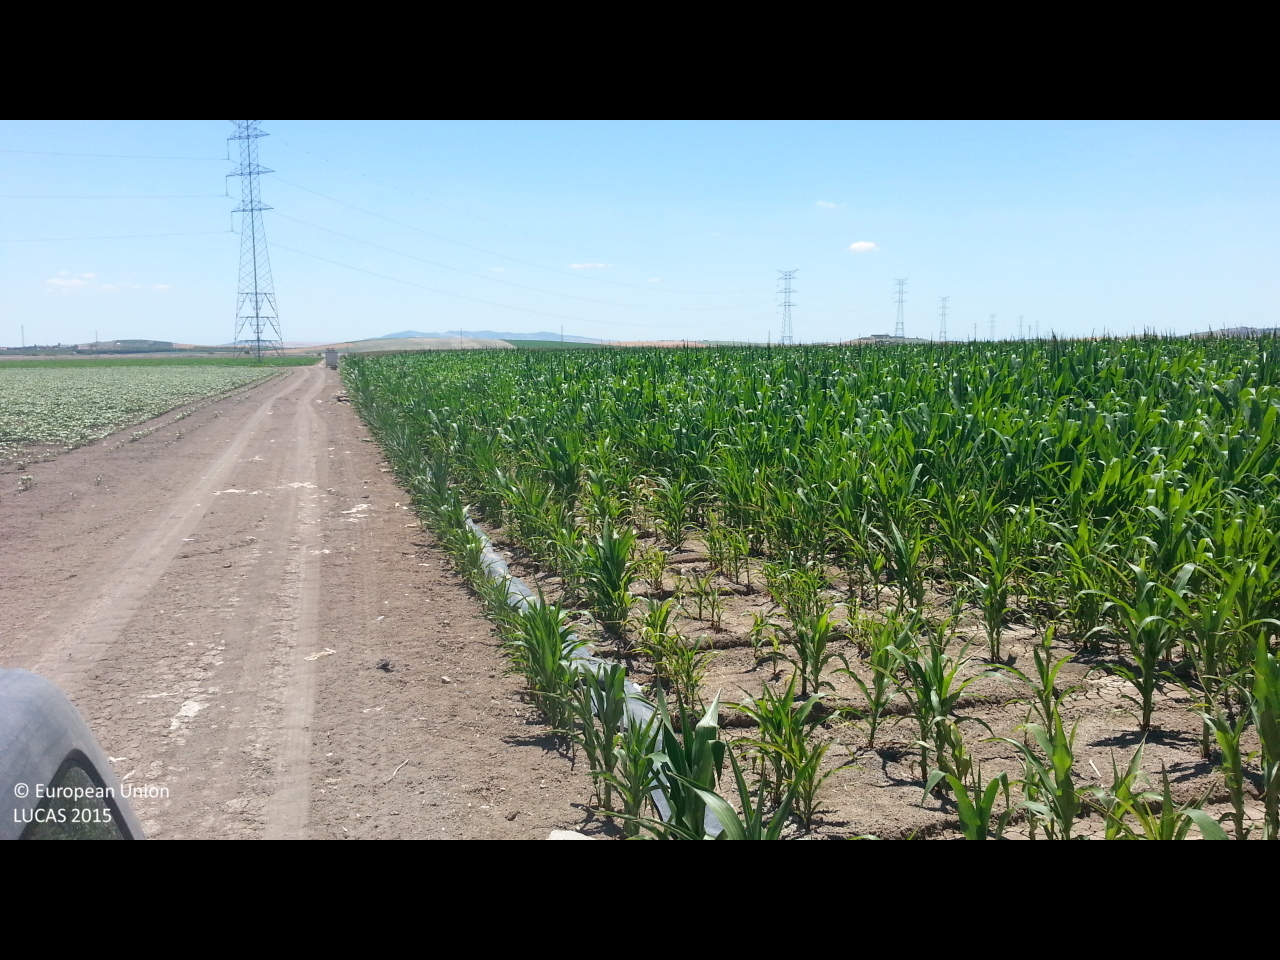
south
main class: Cropland
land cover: Maize
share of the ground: > 75 %
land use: Agriculture (excluding fallow land and kitchen gardens)
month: June
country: ES
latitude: 36.9835
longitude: -6.0485
